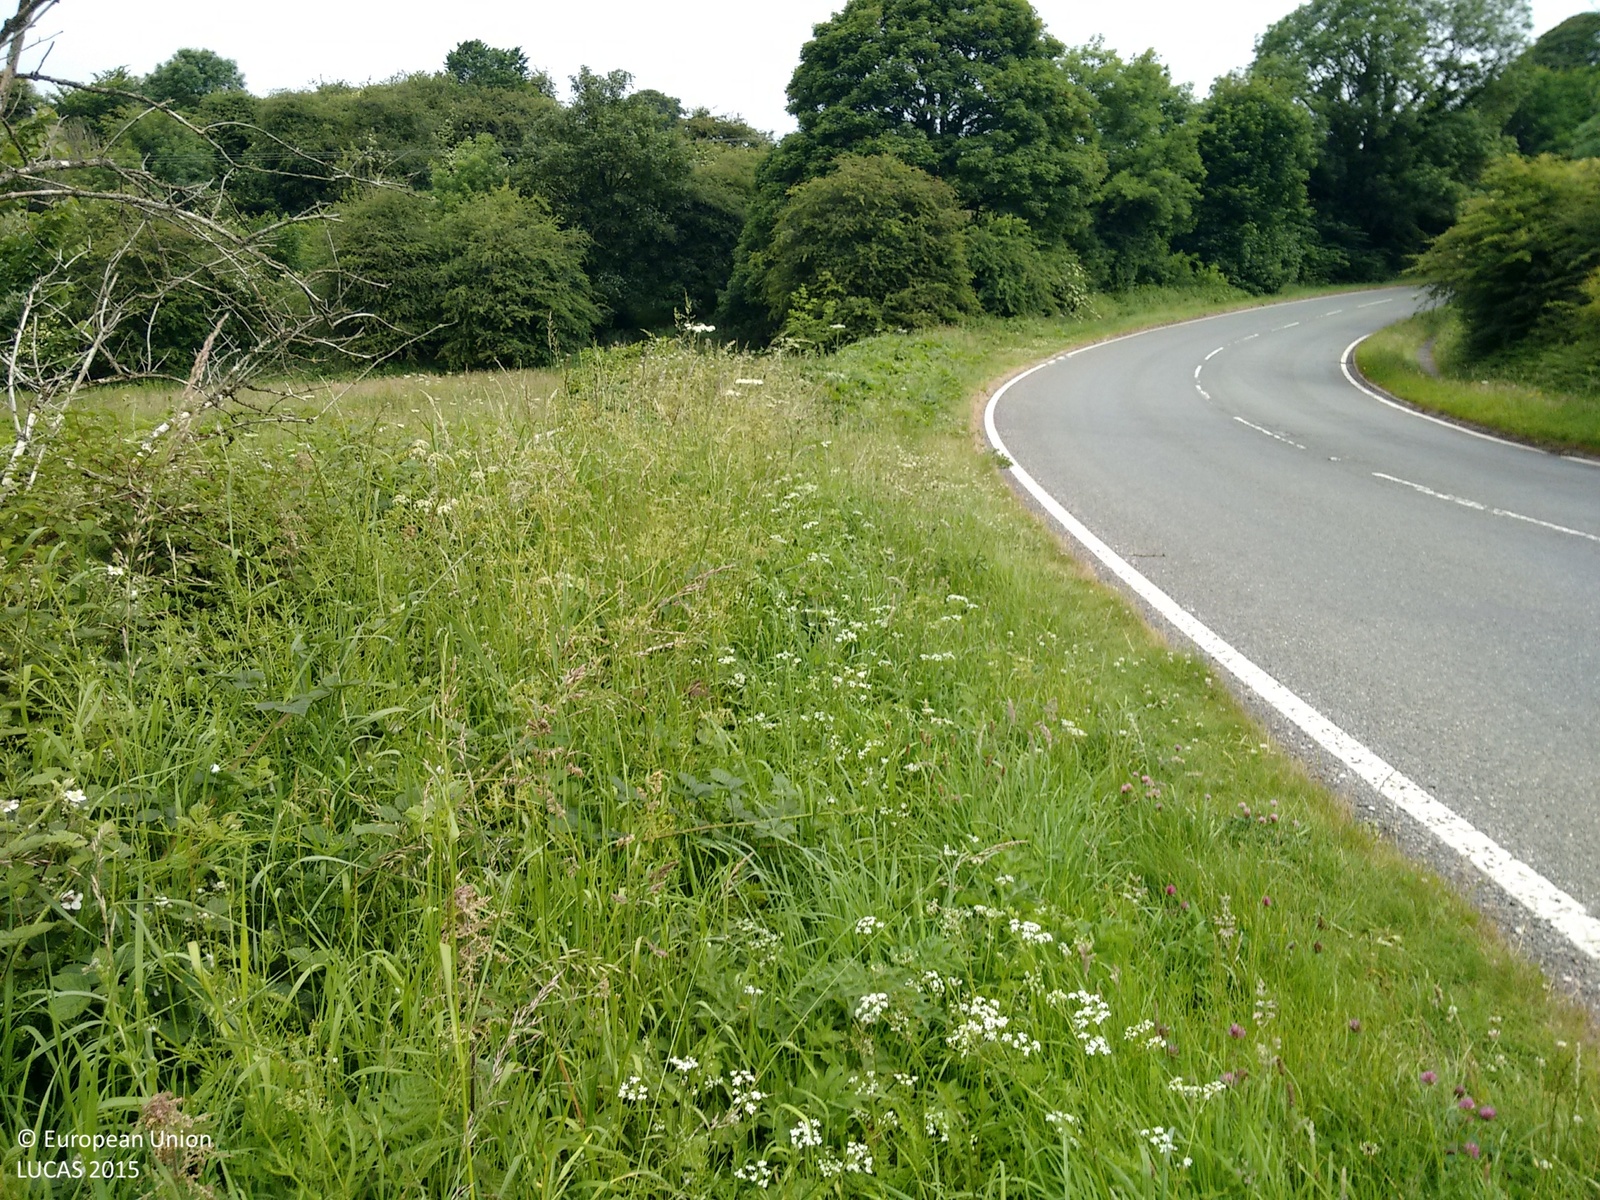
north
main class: Grassland
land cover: Grassland without tree/shrub cover
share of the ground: > 75 %
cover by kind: herbaceous plants 100 %
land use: Agriculture (excluding fallow land and kitchen gardens)
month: June
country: GB
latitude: 53.2741
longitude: -1.6441
